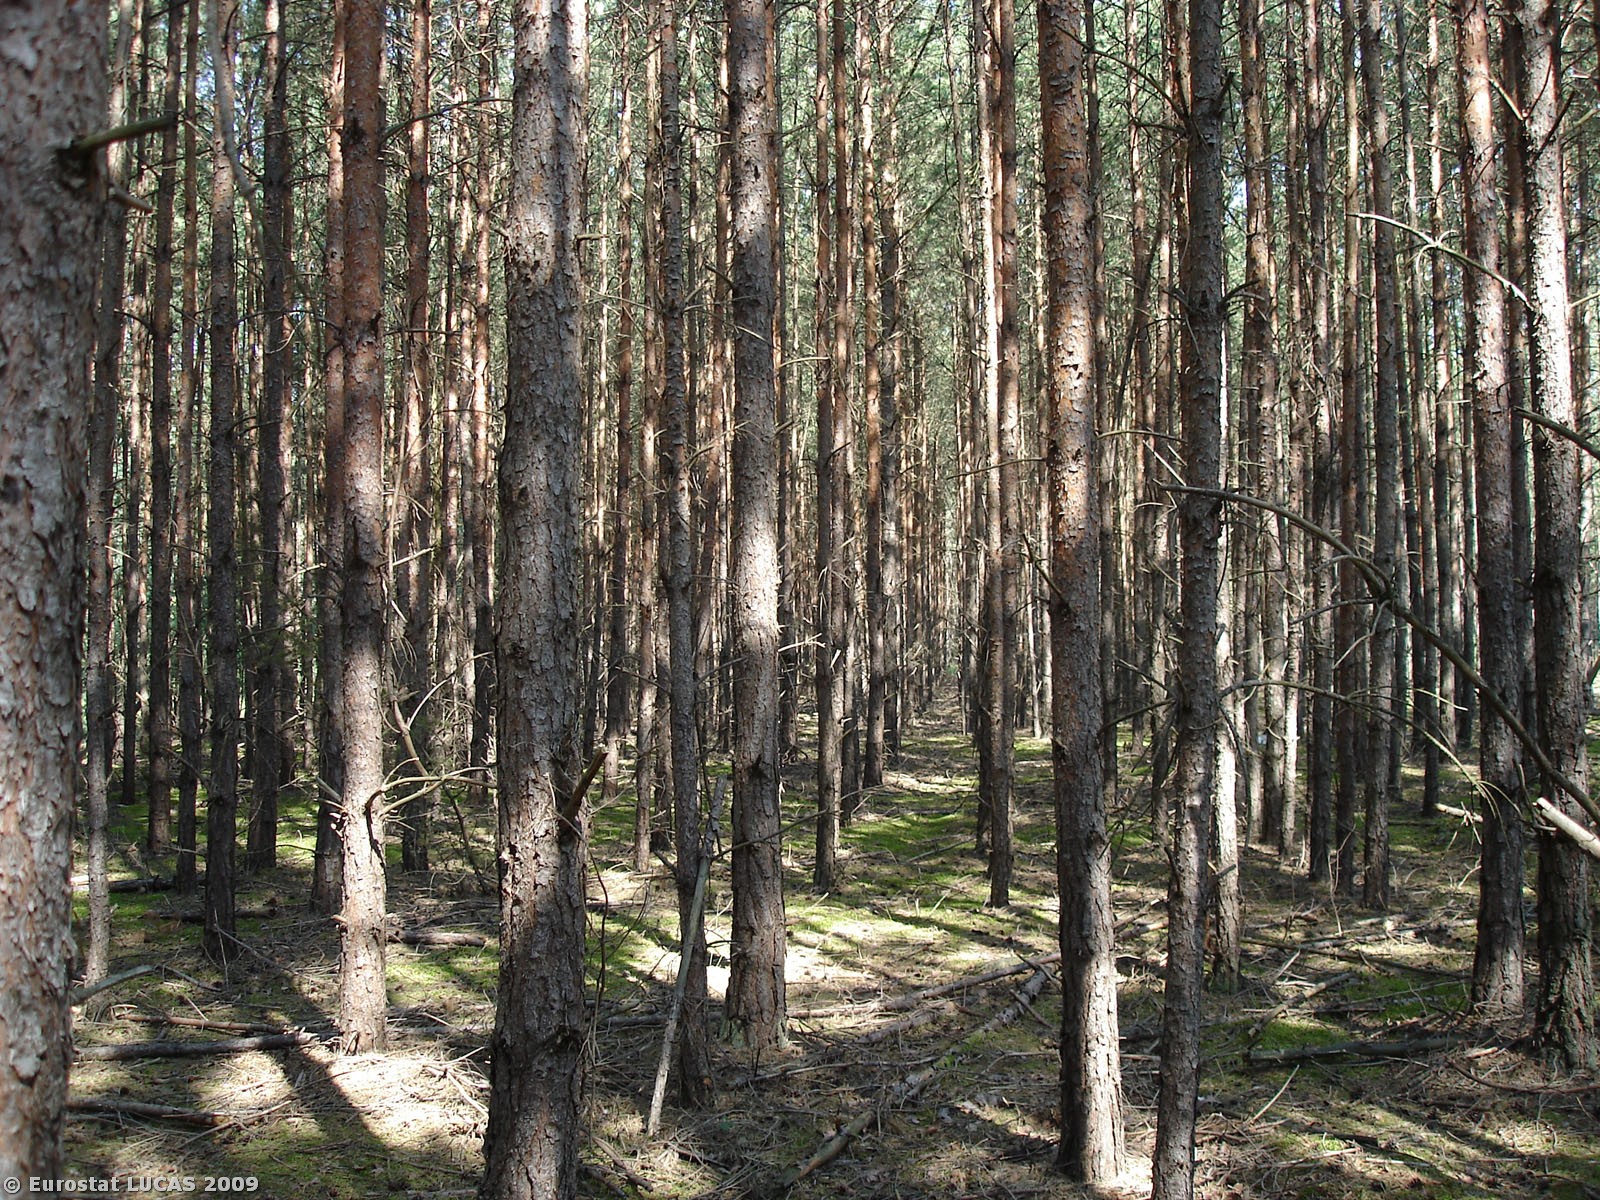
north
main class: Woodland
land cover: Coniferous woodland
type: hemiboreal forest and nemoral coniferous forest and mixed broadleaved-coniferous forest
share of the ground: > 75 %
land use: Forestry
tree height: > 5 m
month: August
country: PL
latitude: 51.0136
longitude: 18.8740
